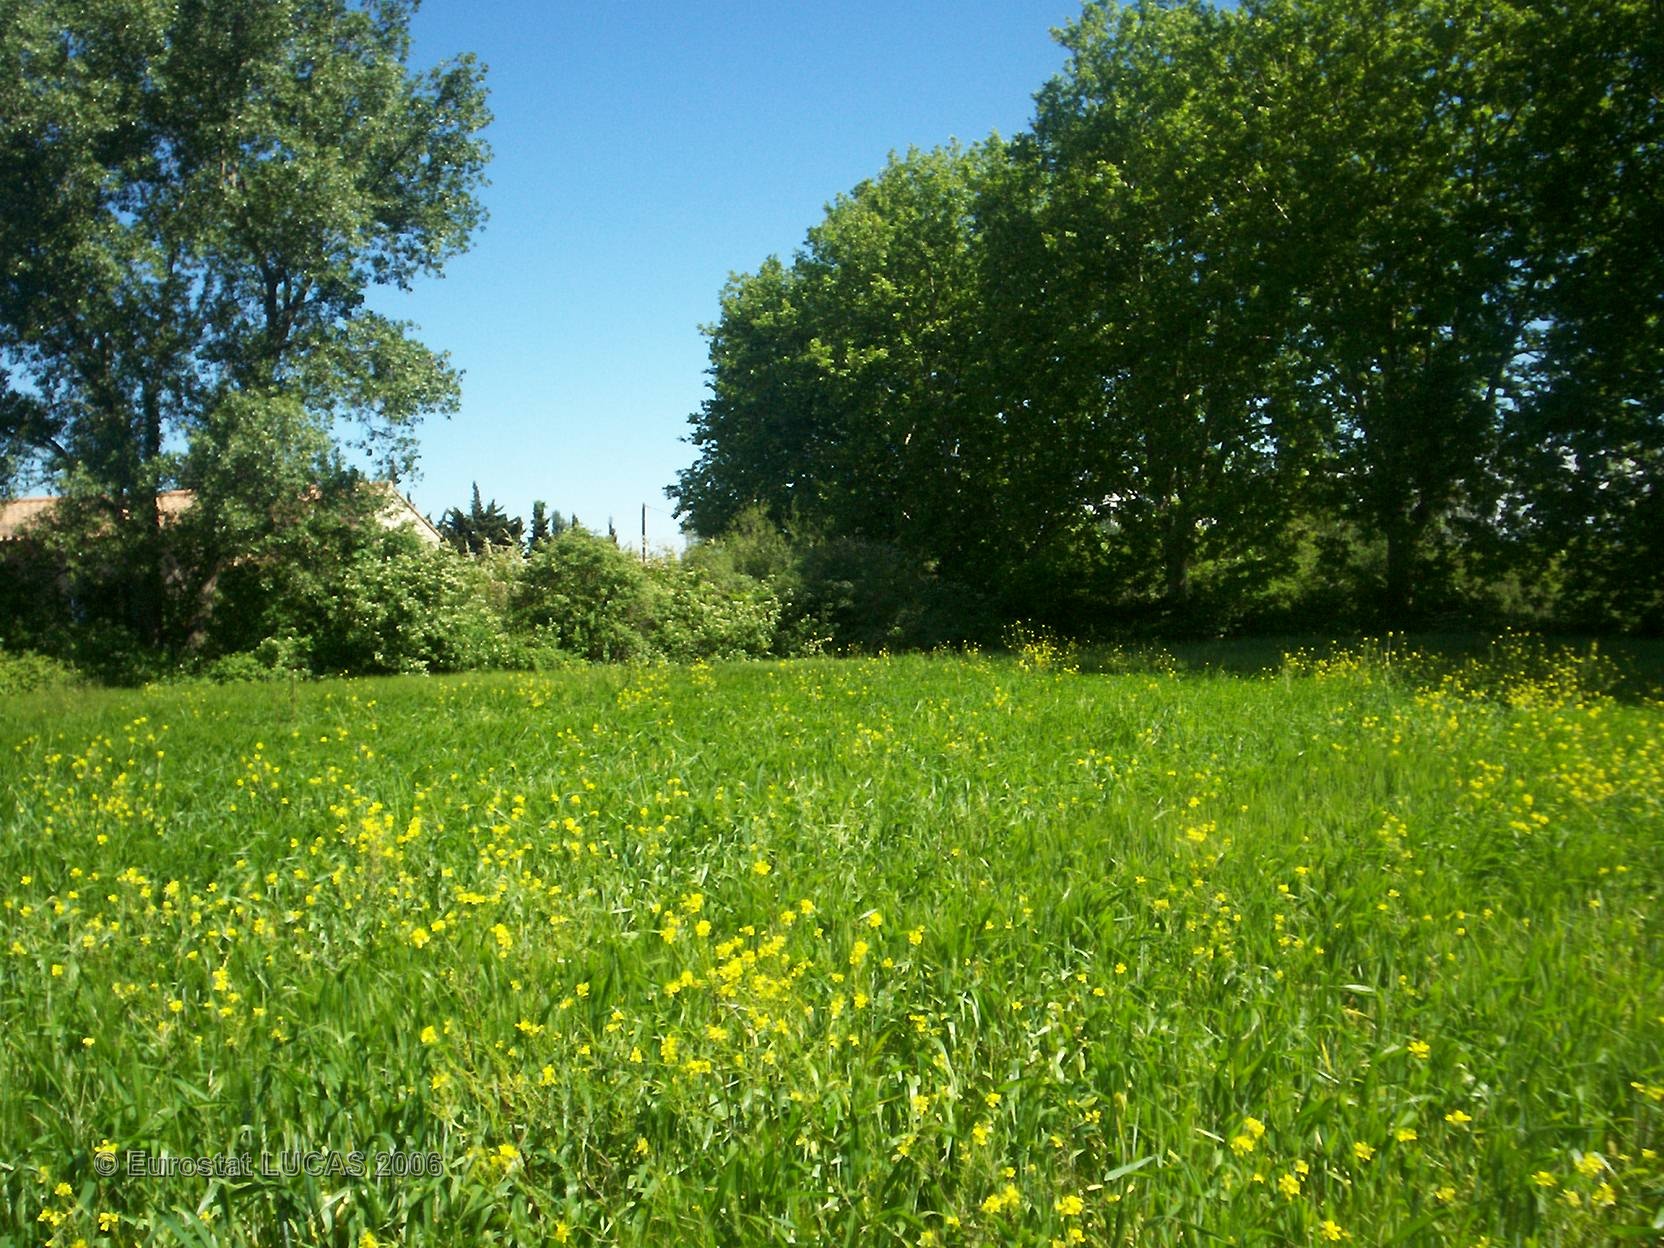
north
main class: Cropland
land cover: Durum wheat
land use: Agriculture (excluding fallow land and kitchen gardens)
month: May
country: FR
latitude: 43.9907
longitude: 4.9087
